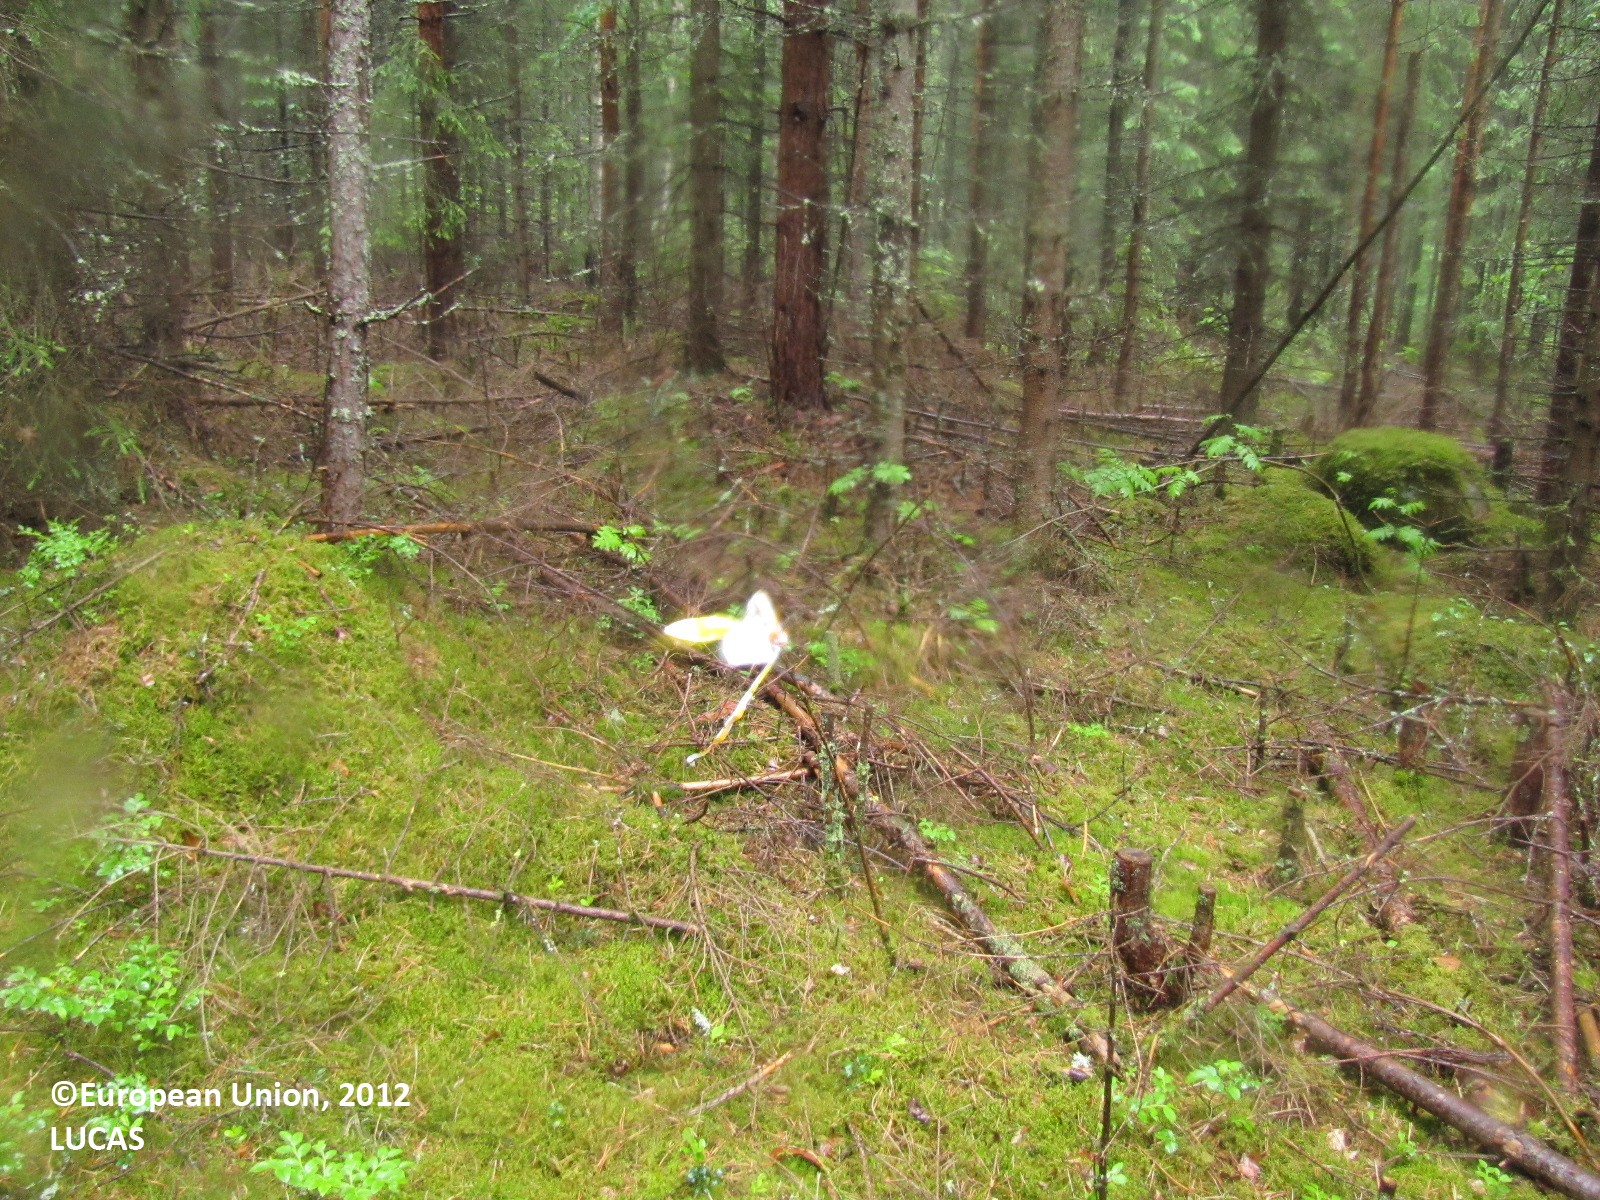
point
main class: Woodland
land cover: Spruce dominated coniferous woodland
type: boreal forest
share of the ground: > 75 %
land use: Forestry
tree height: > 5 m
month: June
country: FI
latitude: 61.6478
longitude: 24.4999
